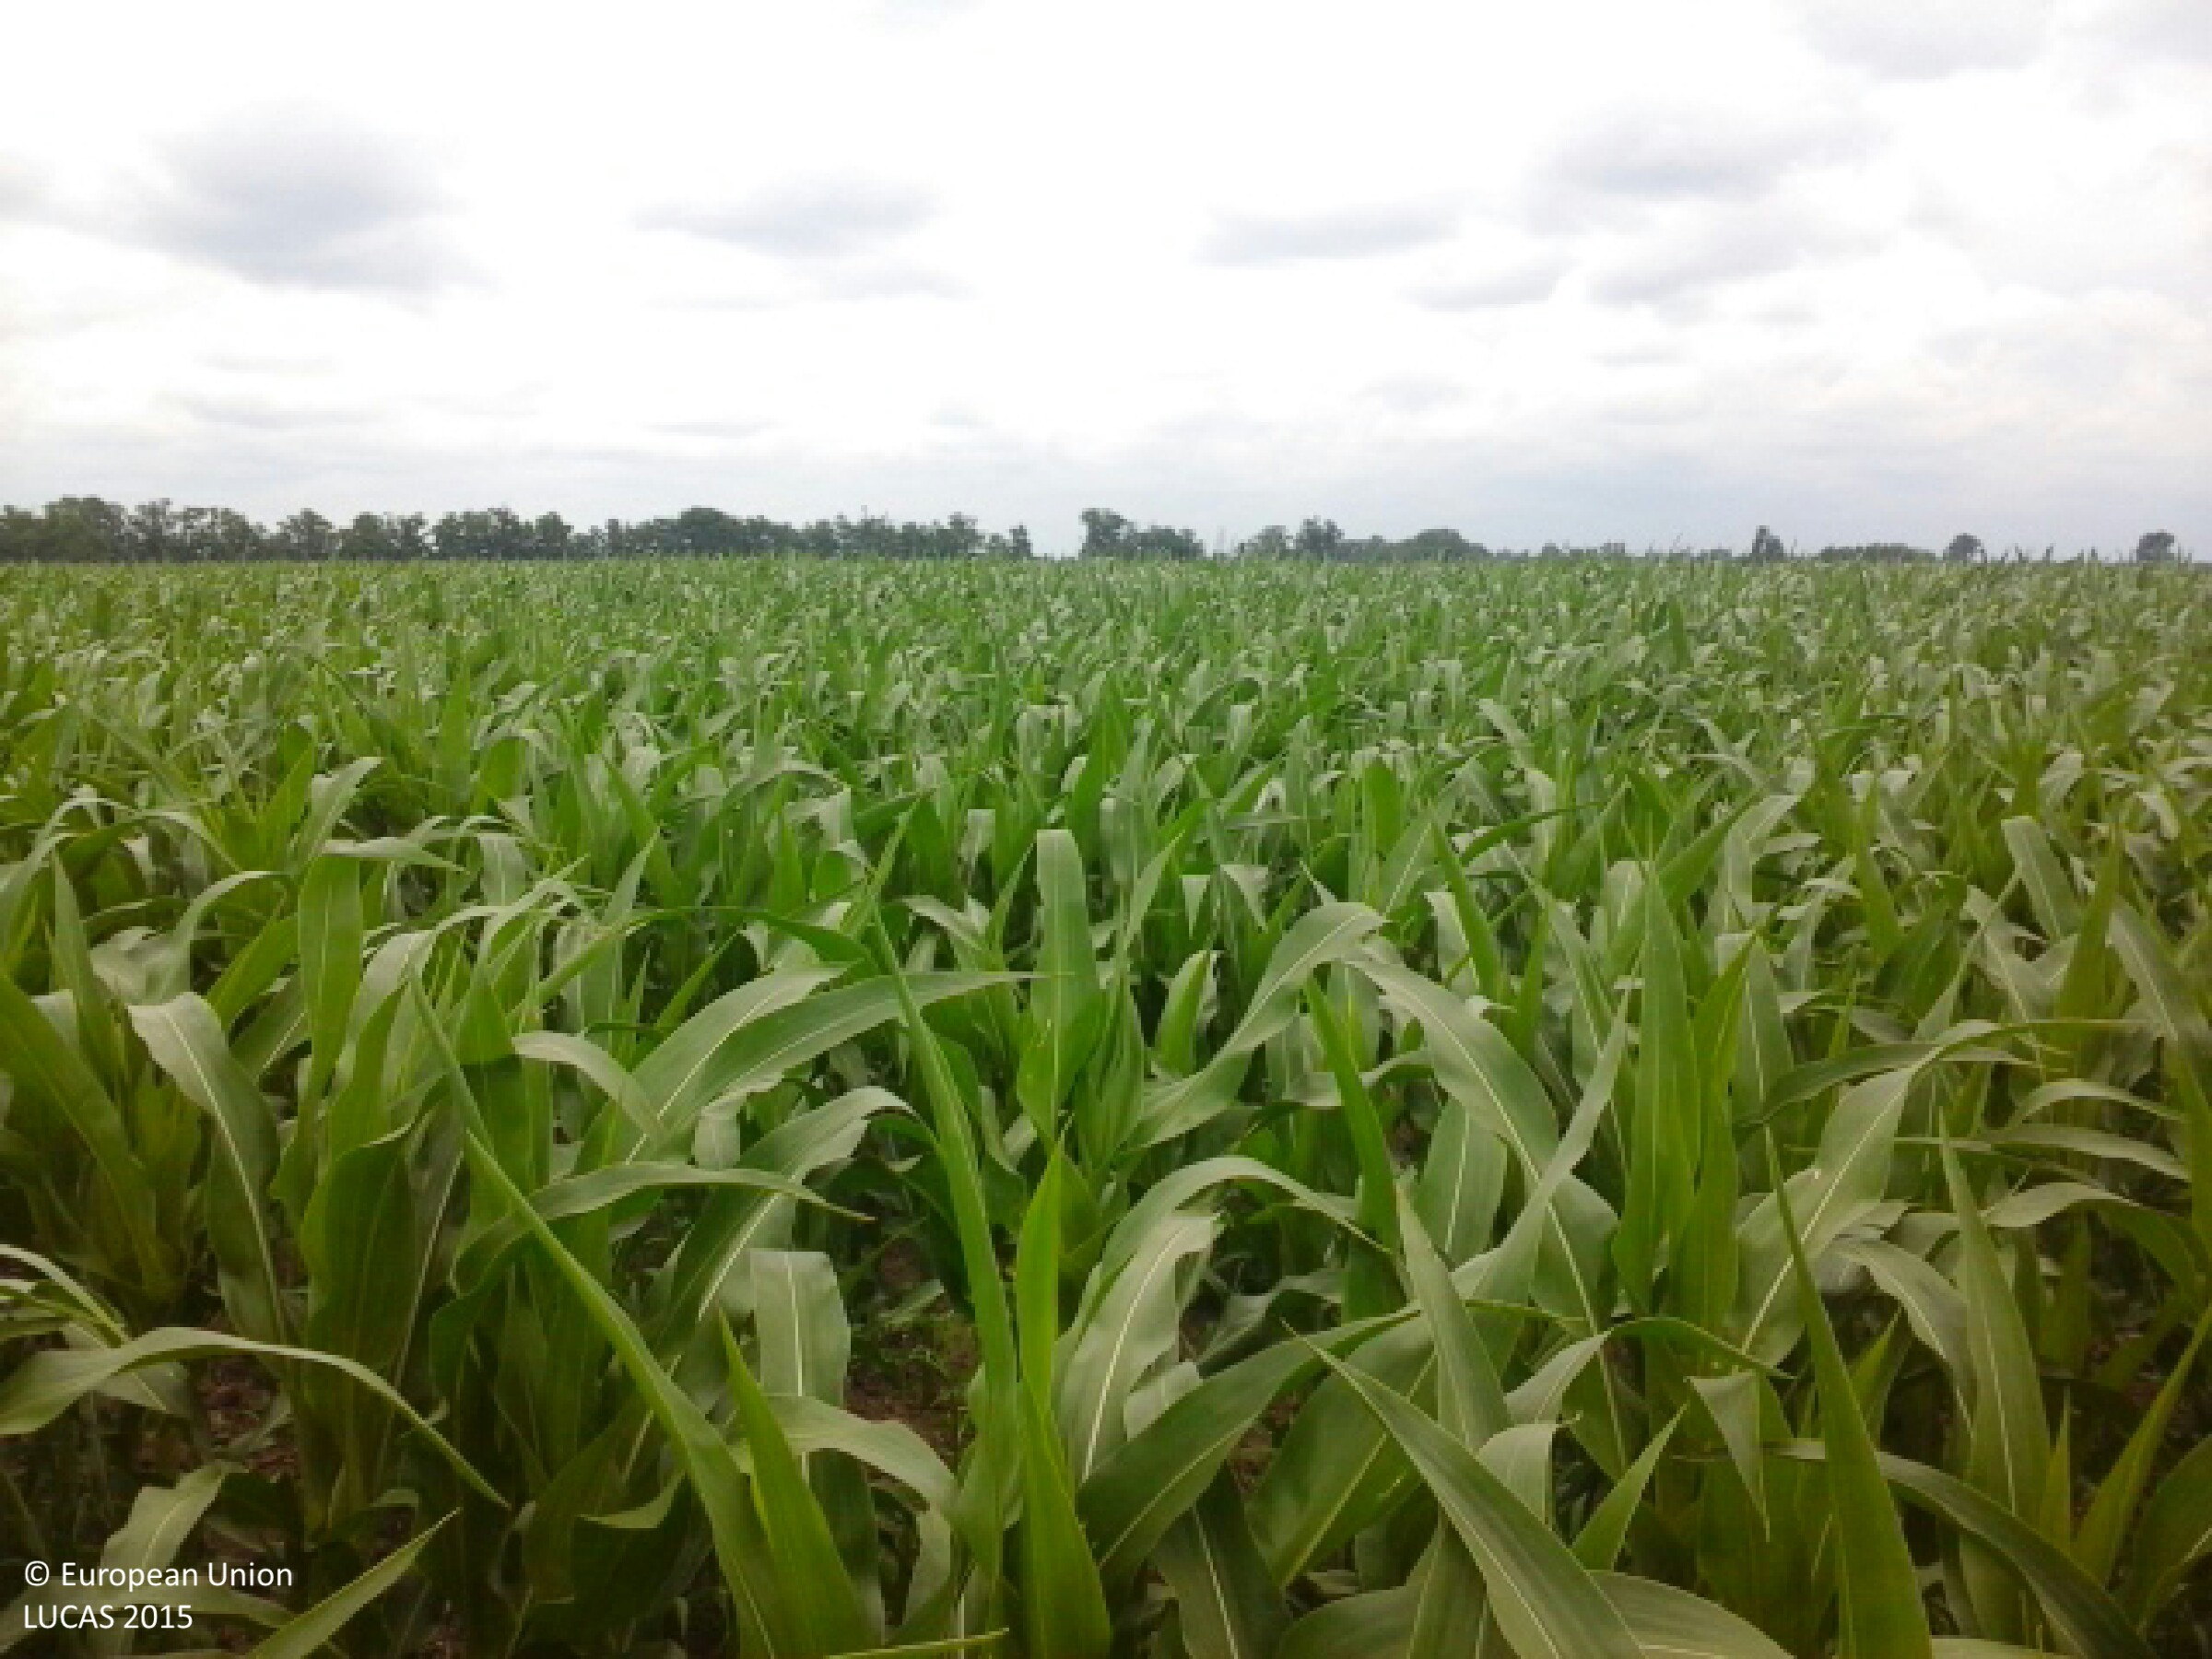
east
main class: Cropland
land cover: Maize
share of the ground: > 75 %
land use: Agriculture (excluding fallow land and kitchen gardens)
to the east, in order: Maize; Grass margins; Inland fresh running water; Grass margins
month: June
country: HU
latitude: 48.1675
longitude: 21.8154
